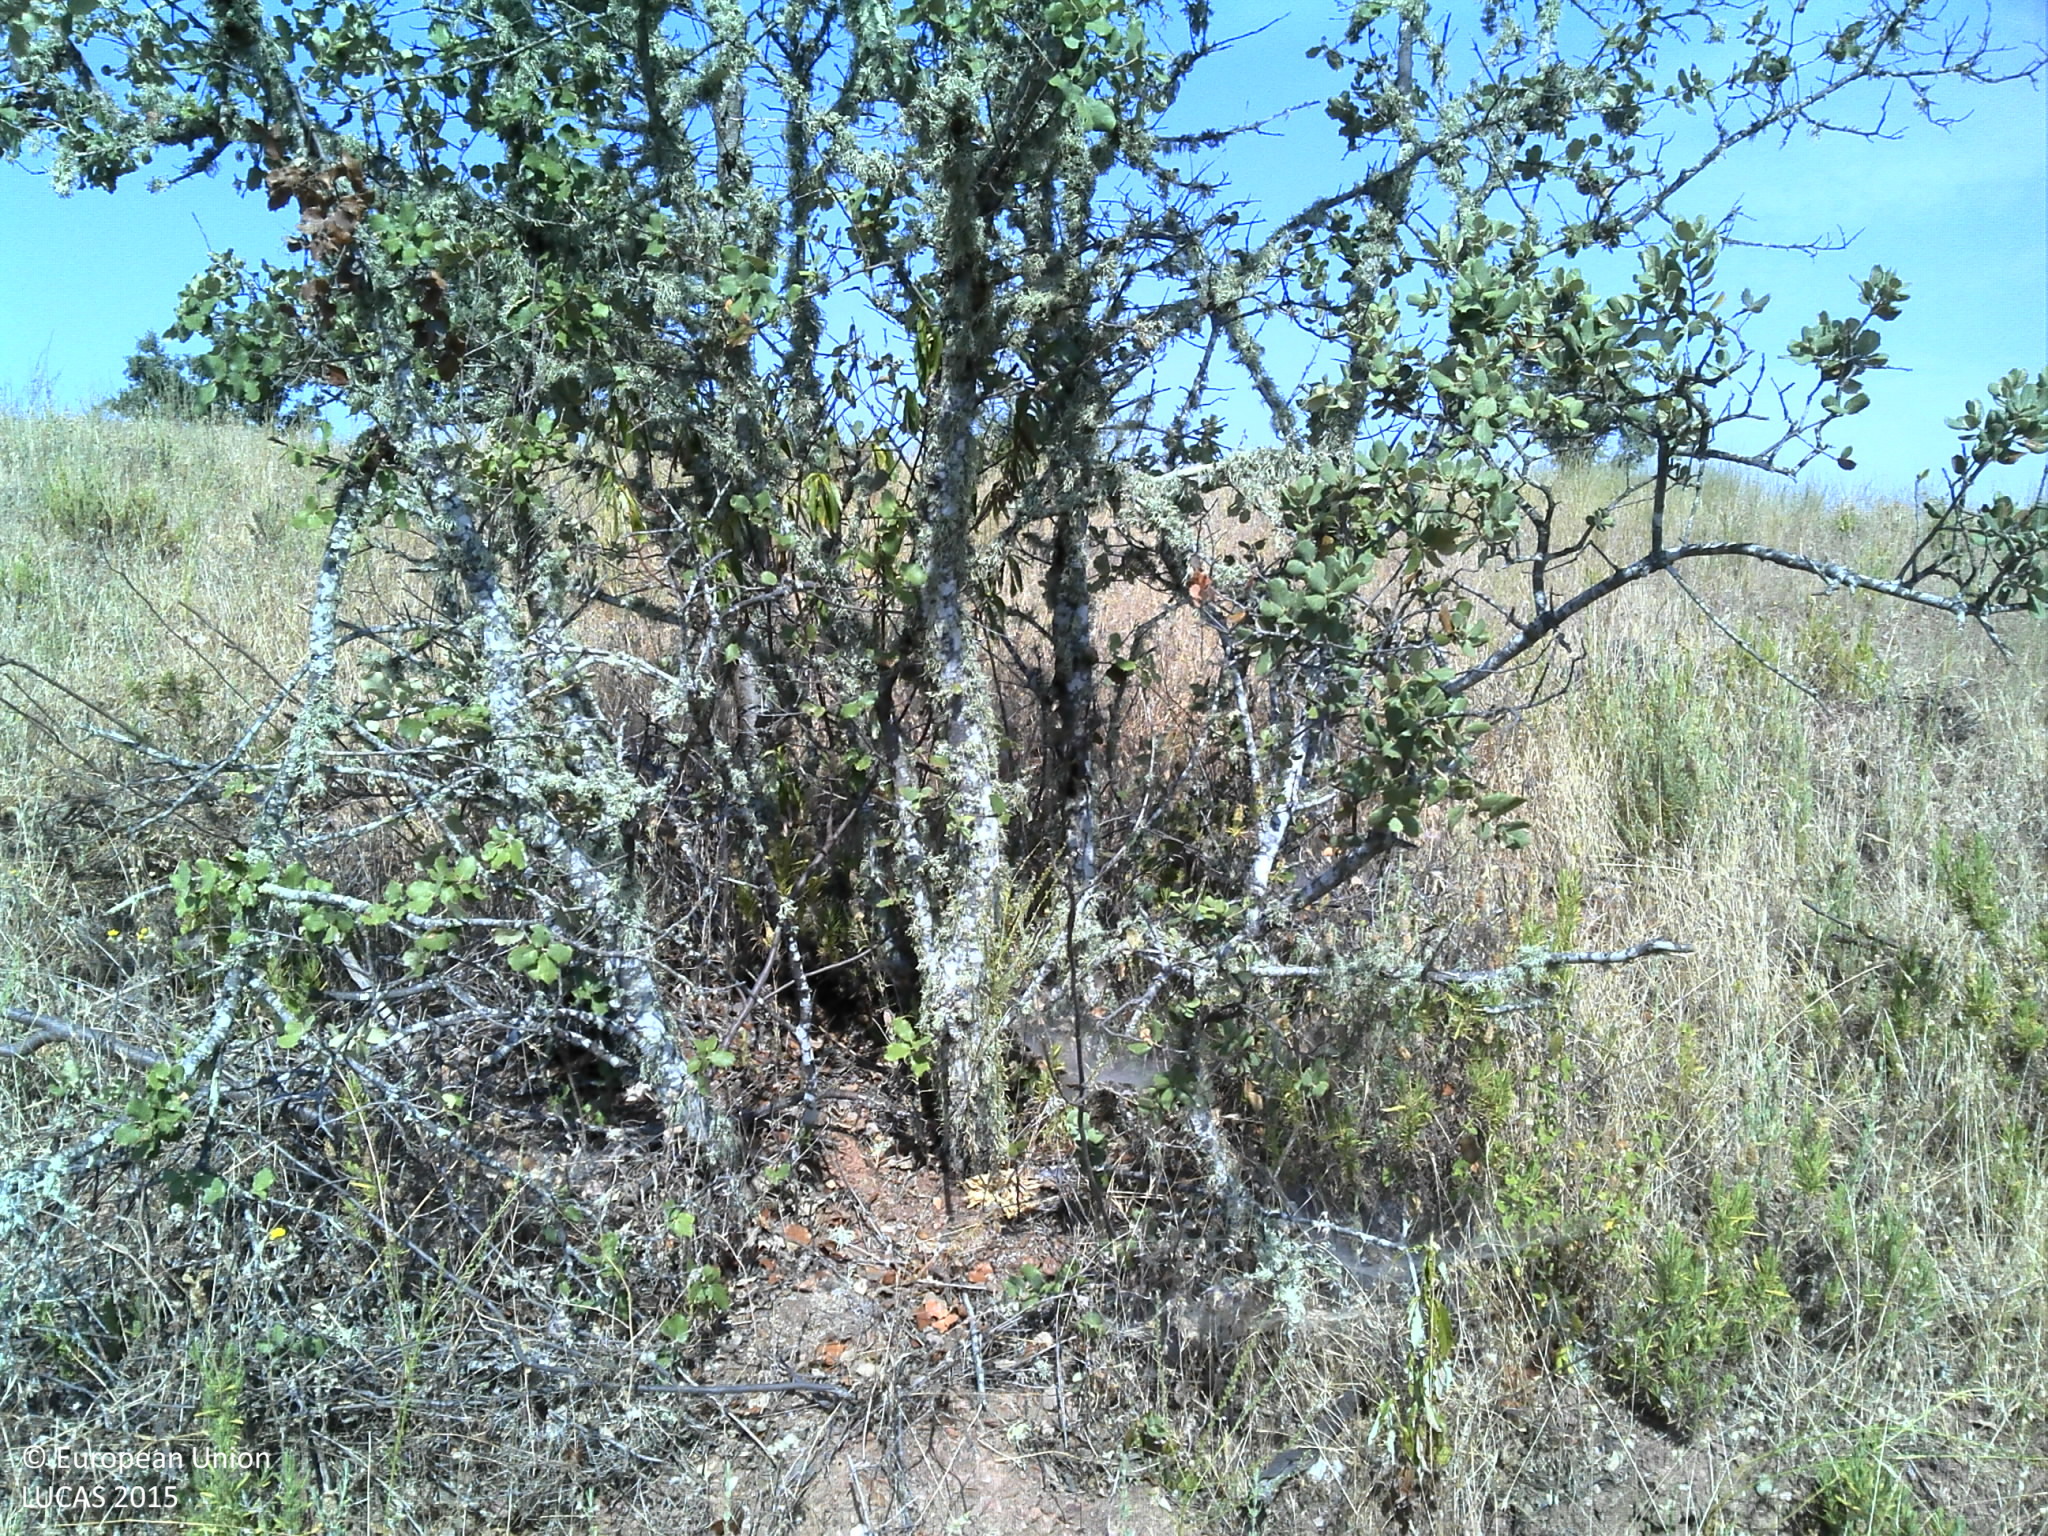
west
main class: Grassland
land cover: Grassland with sparse tree/shrub cover
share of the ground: 50 - 75 %
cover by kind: herbaceous plants 95 %, broadleaved forest trees 5 %
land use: Agriculture (excluding fallow land and kitchen gardens)
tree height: < 5 m
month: June
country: PT
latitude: 37.7776
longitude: -7.4879
